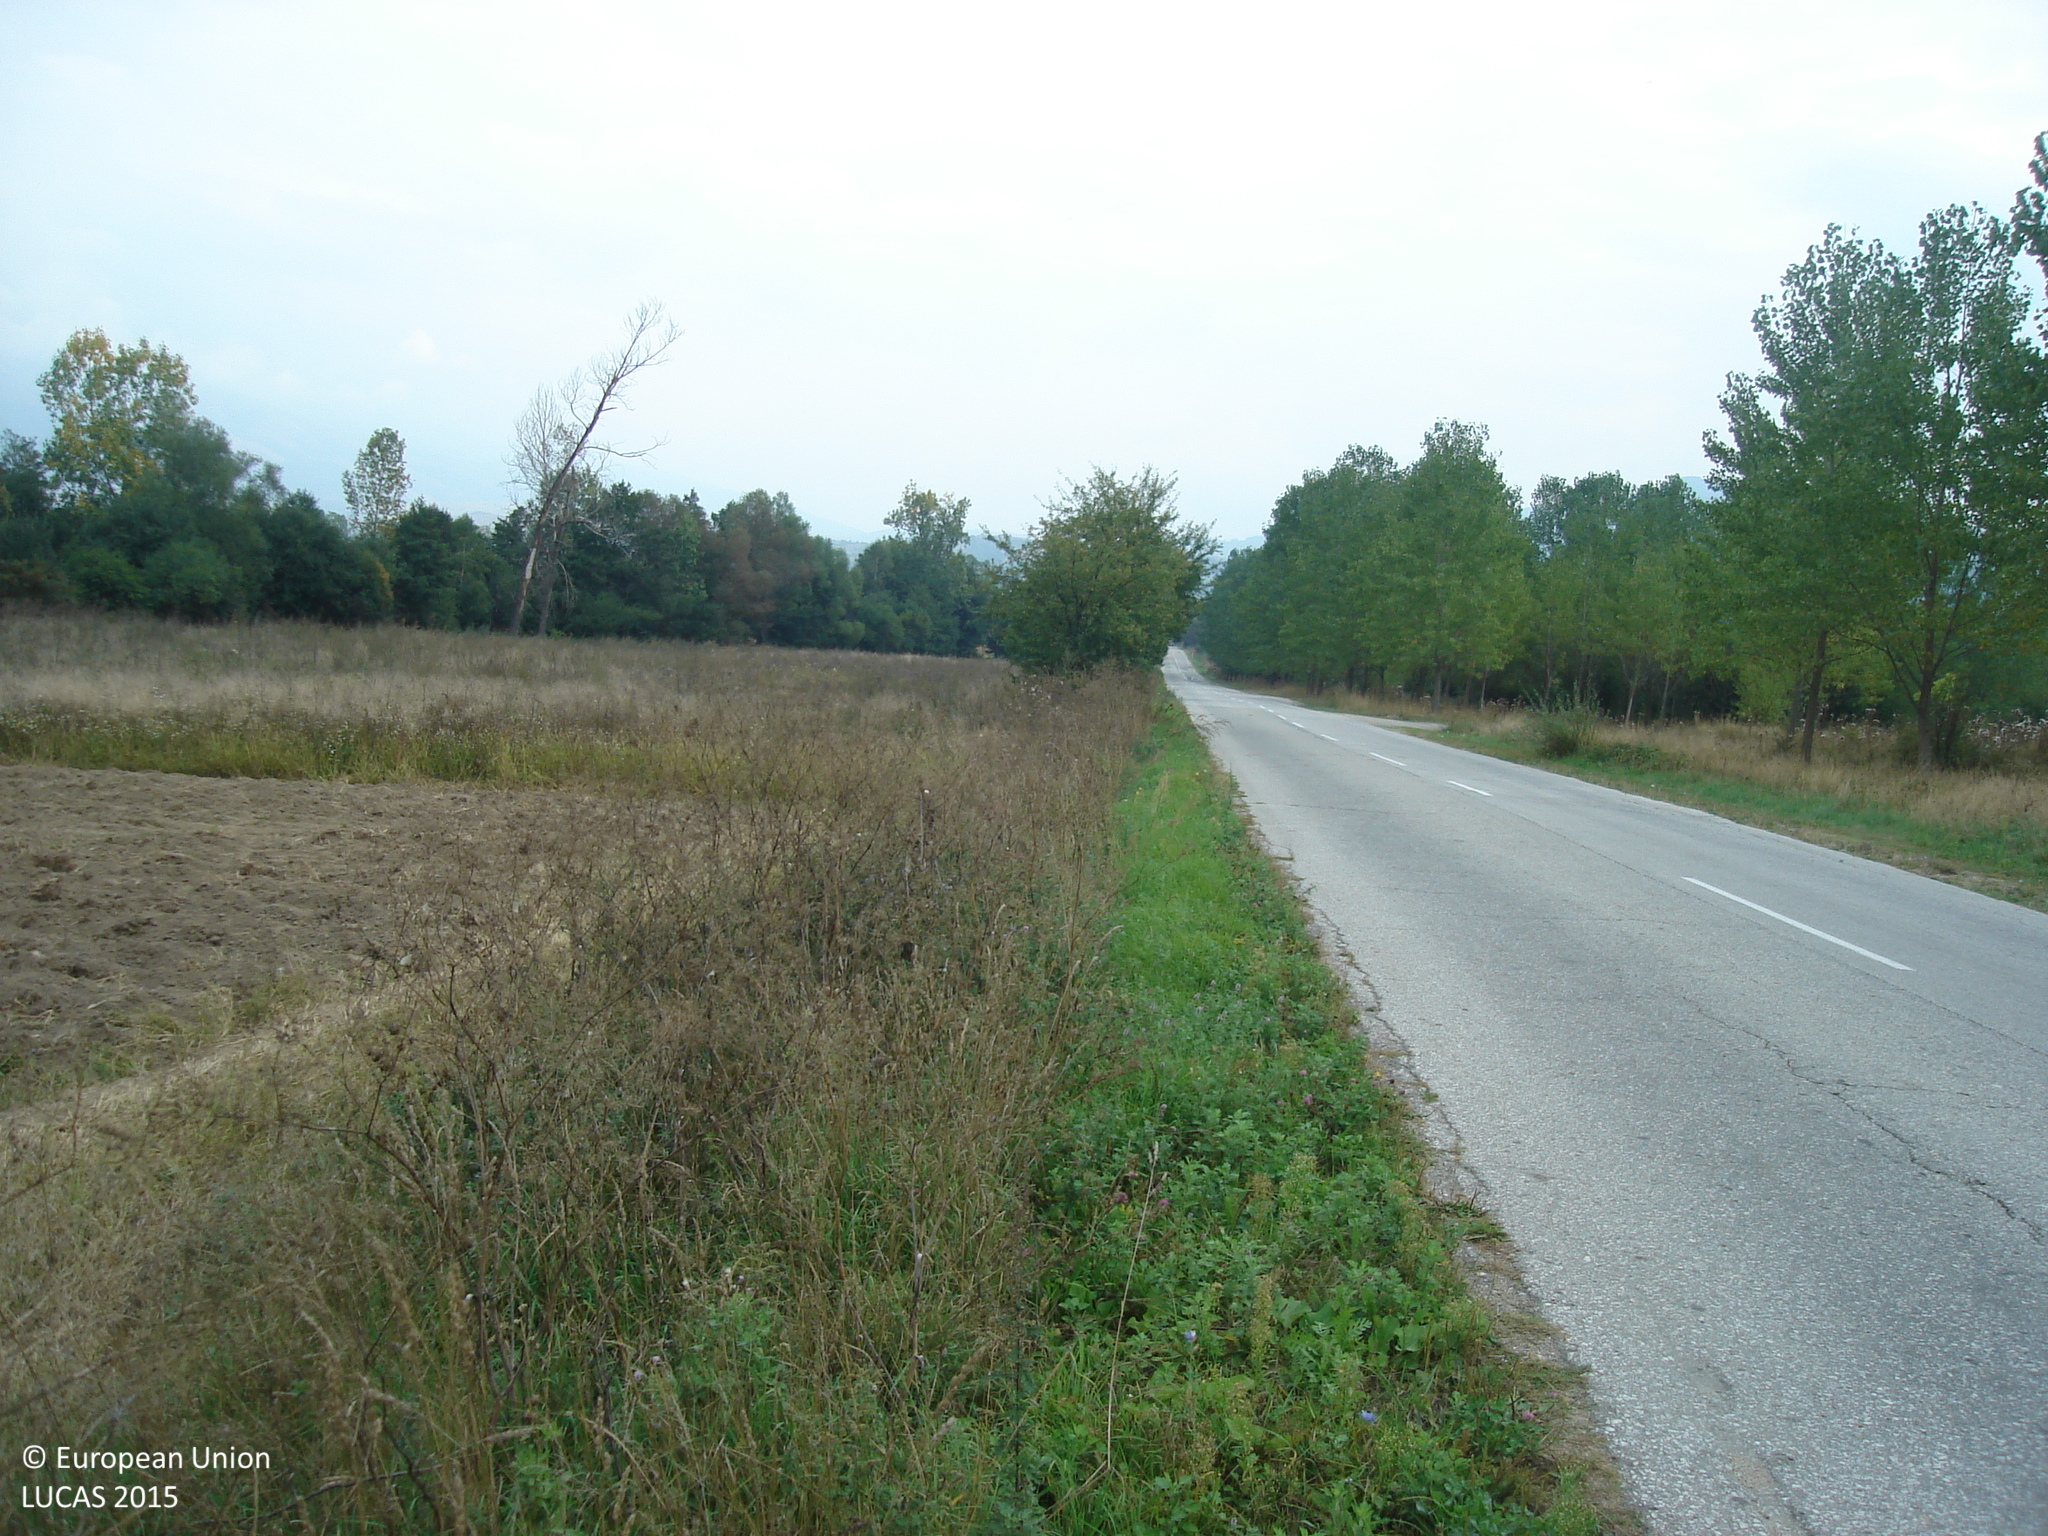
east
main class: Grassland
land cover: Grassland without tree/shrub cover
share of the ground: > 75 %
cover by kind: herbaceous plants 100 %
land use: Road transport
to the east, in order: Grass margins; Grassland without tree/shrub cover; Potatoes; Grassland without tree/shrub cover; Grass margins; Broadleaved woodland; Rivers and streams; Broadleaved woodland
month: September
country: BG
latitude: 42.7063
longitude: 24.2229
